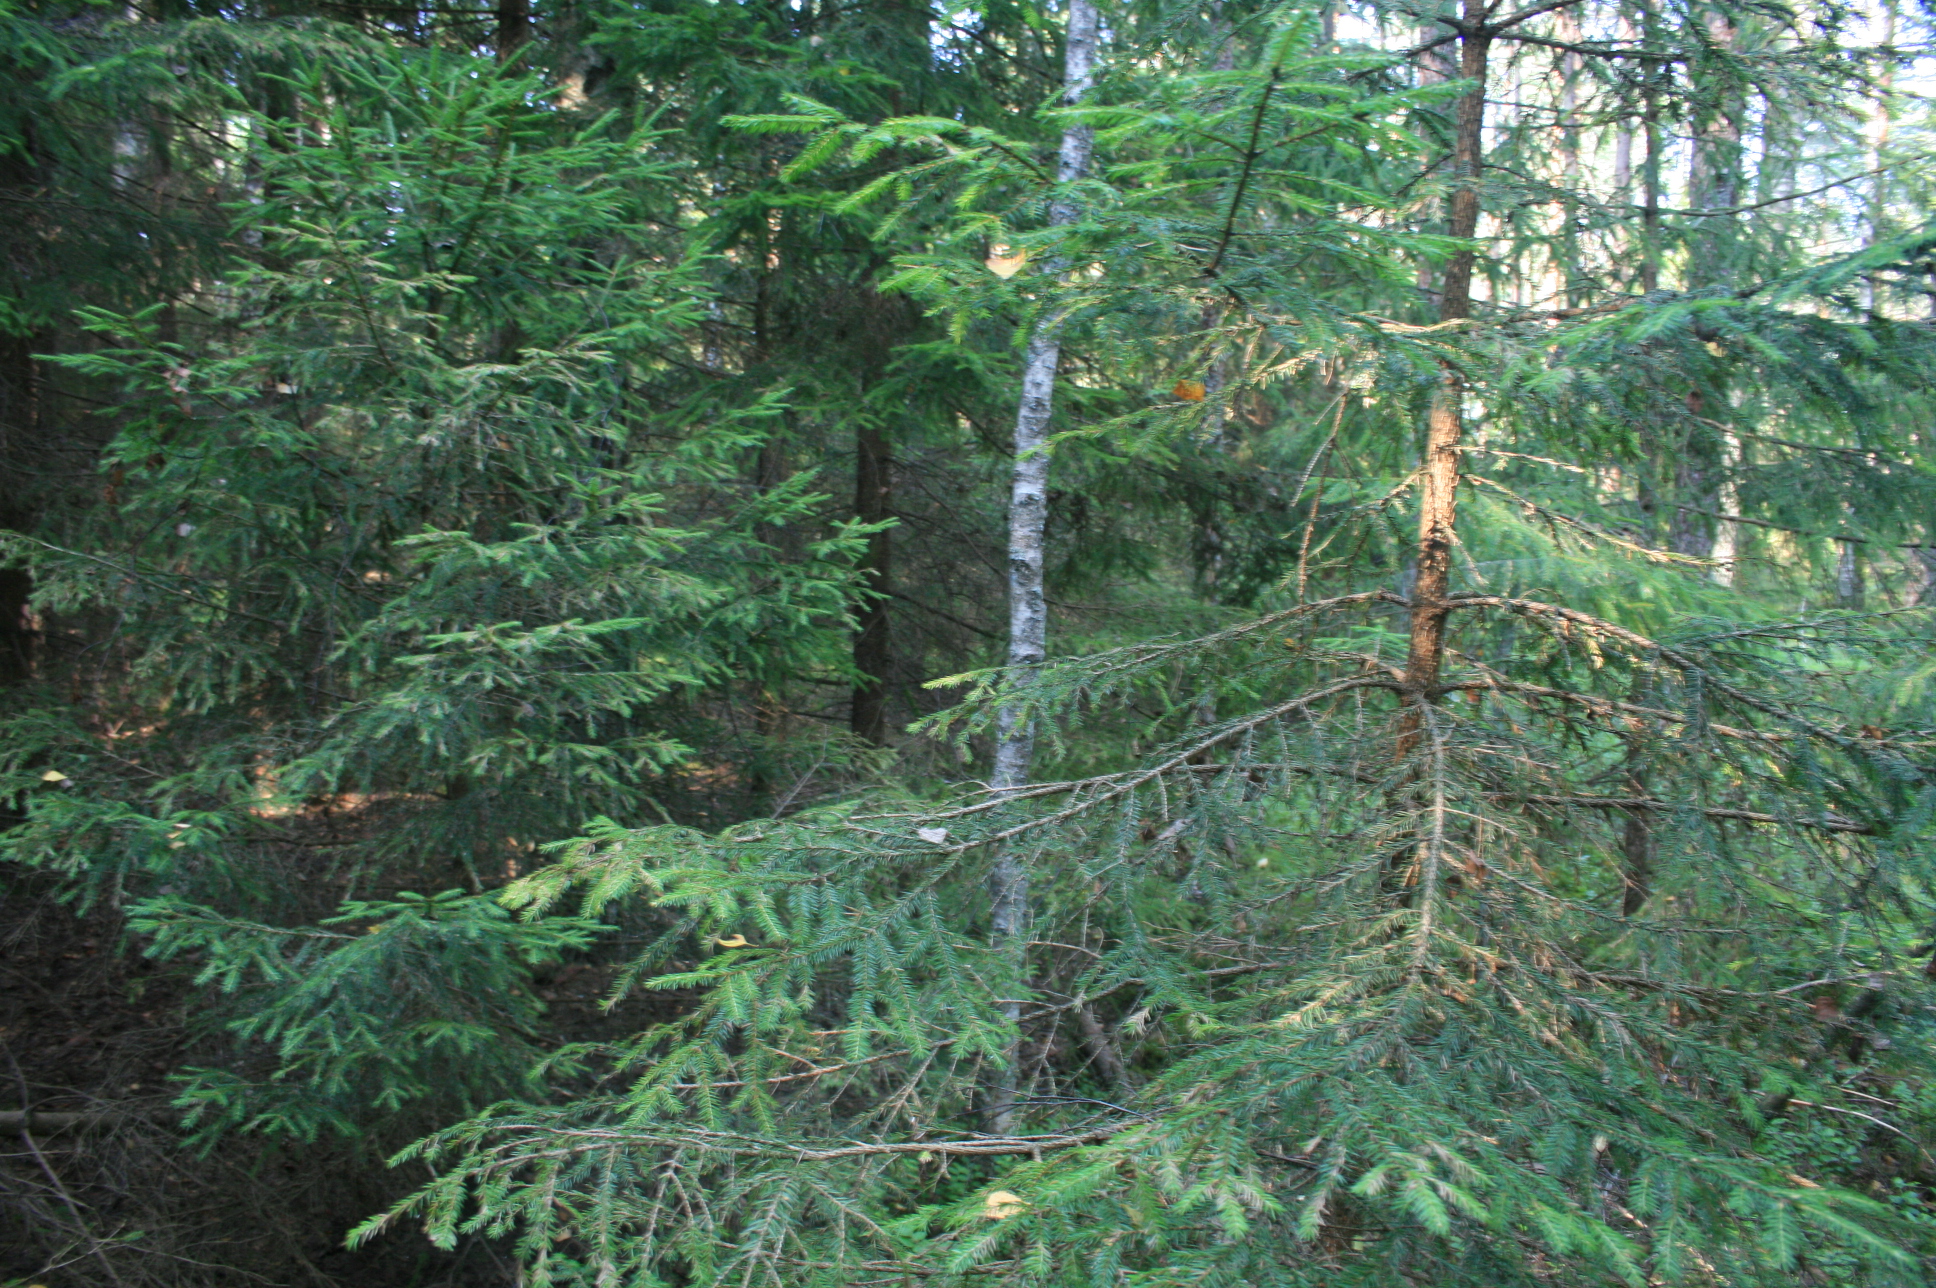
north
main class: Woodland
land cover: Spruce dominated mixed woodland
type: hemiboreal forest and nemoral coniferous forest and mixed broadleaved-coniferous forest
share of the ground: > 75 %
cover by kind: coniferous forest trees 60 %, broadleaved forest trees 30 %, shrubs 5 %, lichens and mosses 5 %
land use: Forestry
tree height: > 5 m
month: August
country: LT
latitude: 55.5178
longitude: 21.5607
